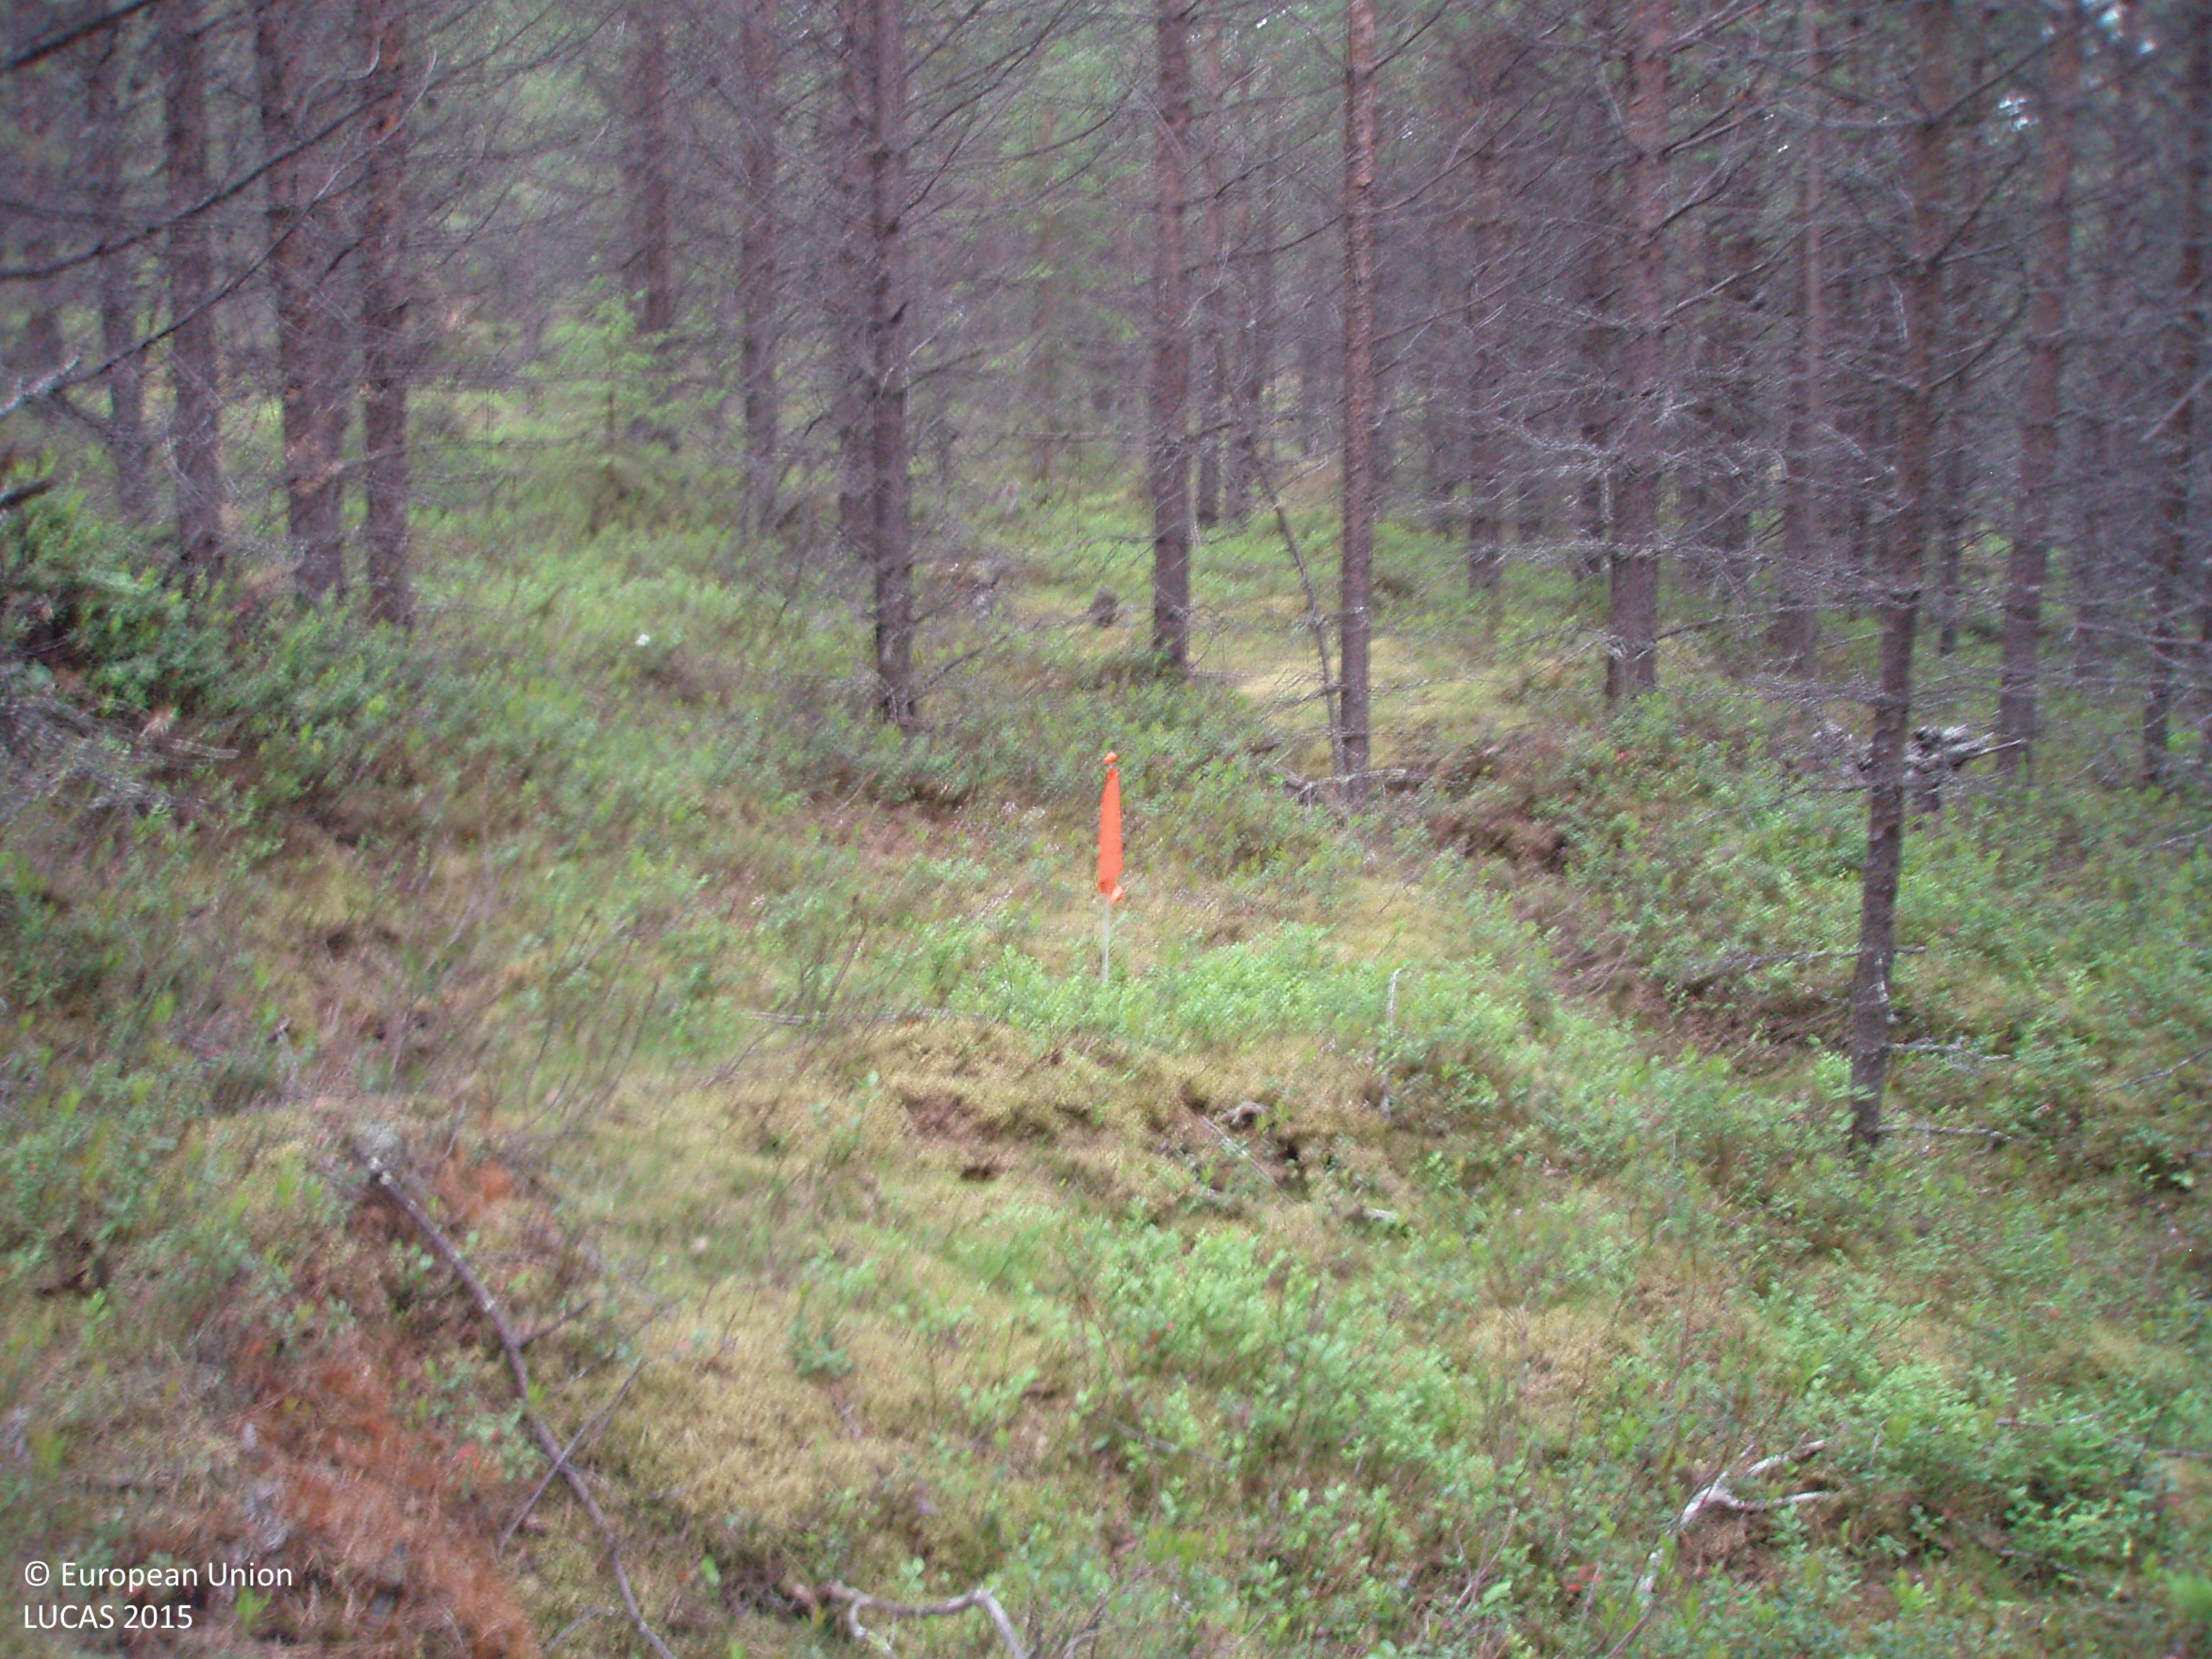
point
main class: Woodland
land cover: Pine dominated coniferous woodland
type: boreal forest
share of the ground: > 75 %
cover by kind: coniferous forest trees 90 %, shrubs 10 %
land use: Forestry
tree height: > 5 m
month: July
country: FI
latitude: 67.4833
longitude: 28.8853
